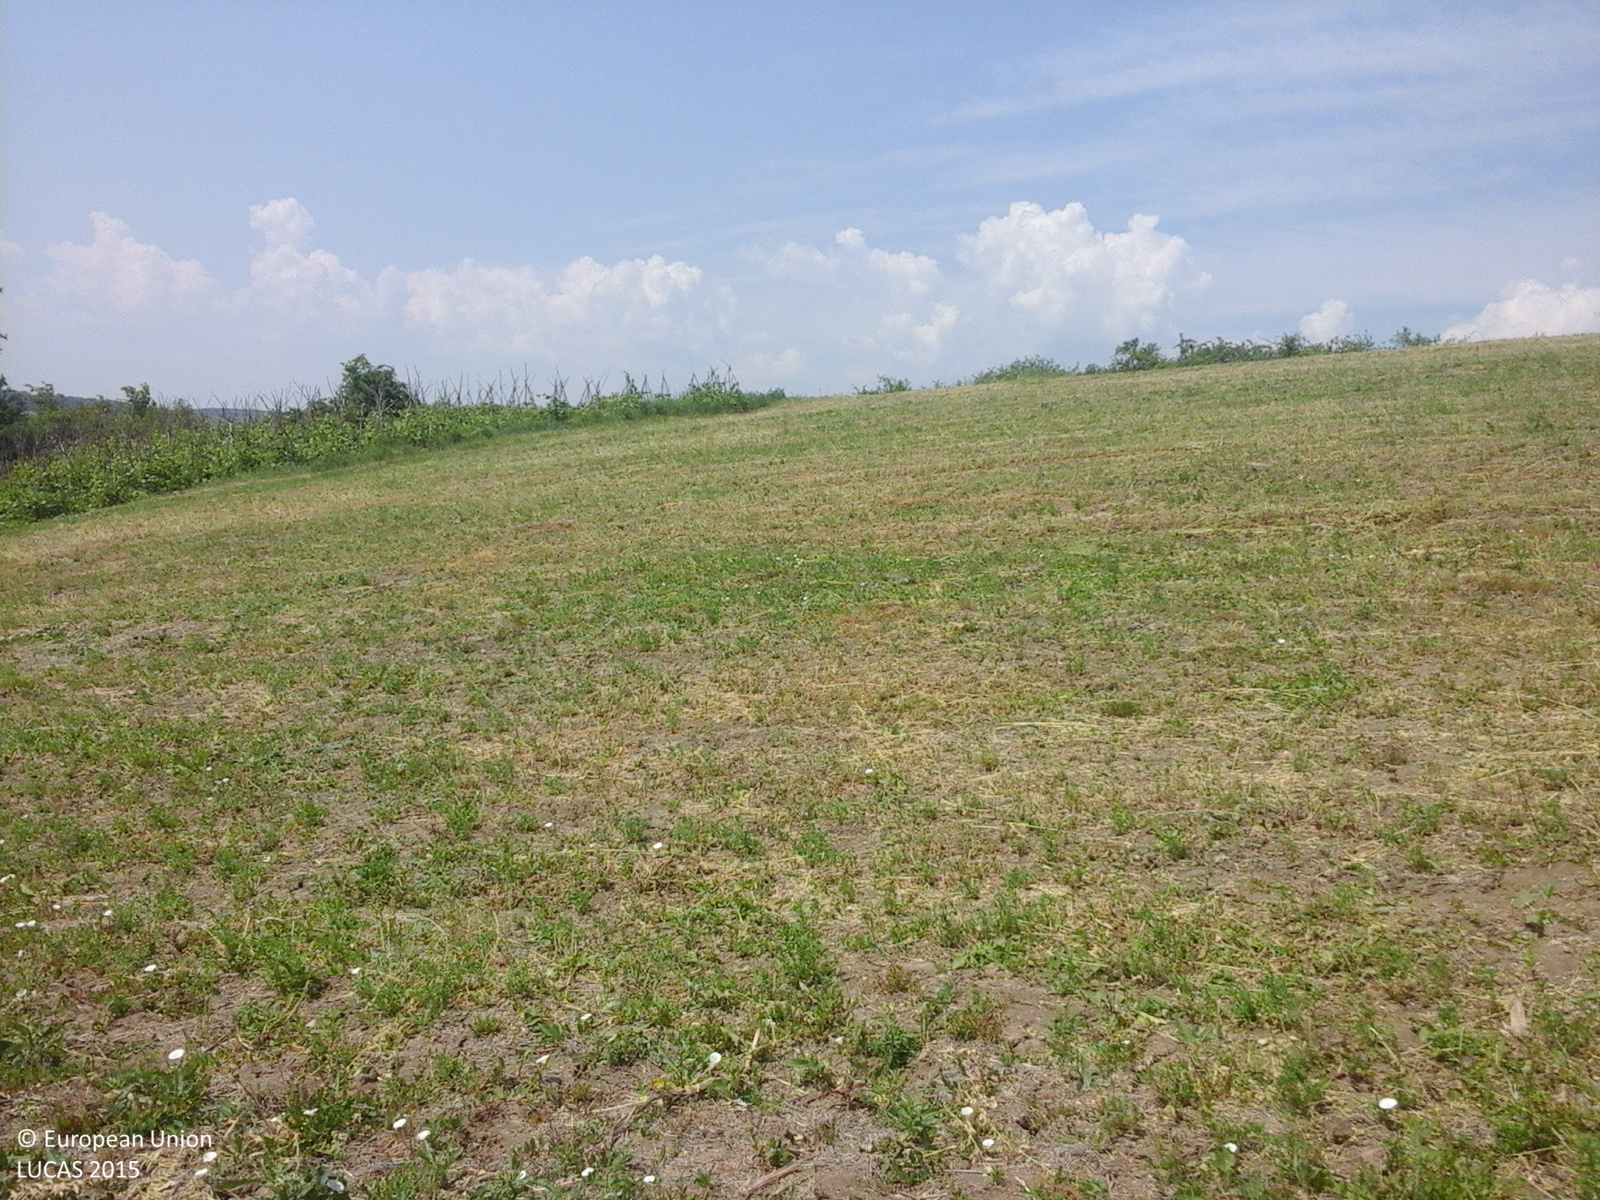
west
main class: Grassland
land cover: Spontaneously vegetated surfaces
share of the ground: > 75 %
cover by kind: herbaceous plants 100 %
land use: Agriculture (excluding fallow land and kitchen gardens)
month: June
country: RO
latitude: 46.3923
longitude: 27.1217
